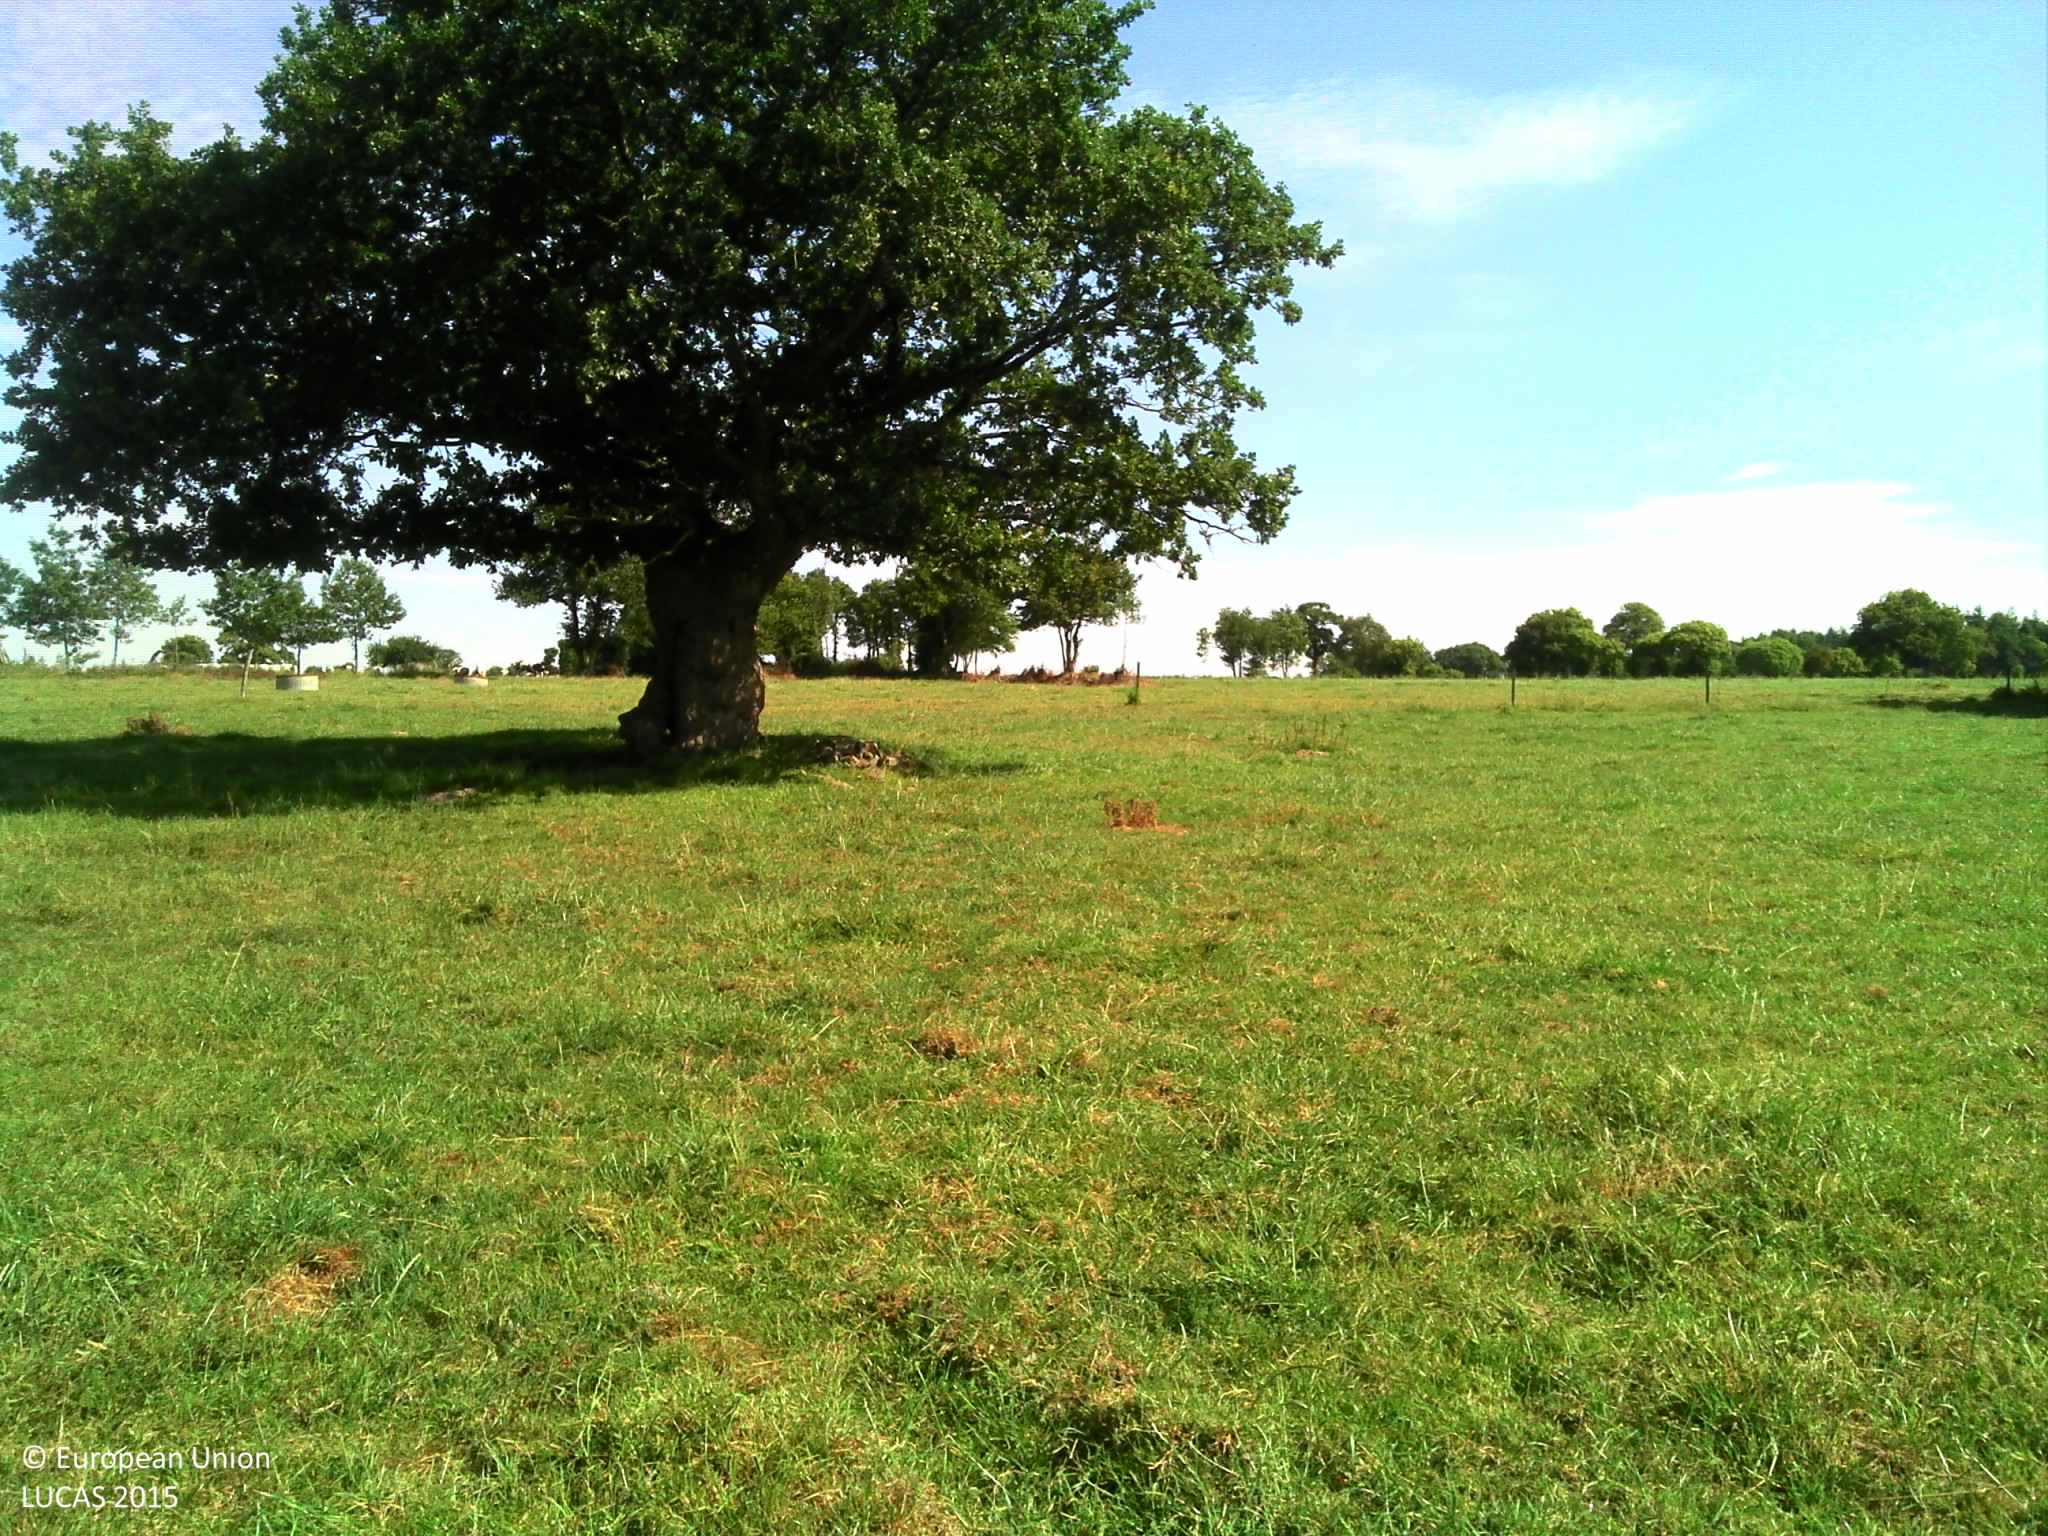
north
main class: Grassland
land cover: Grassland without tree/shrub cover
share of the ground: > 75 %
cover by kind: herbaceous plants 100 %
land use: Agriculture (excluding fallow land and kitchen gardens)
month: June
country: FR
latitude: 47.9760
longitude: -2.0695
